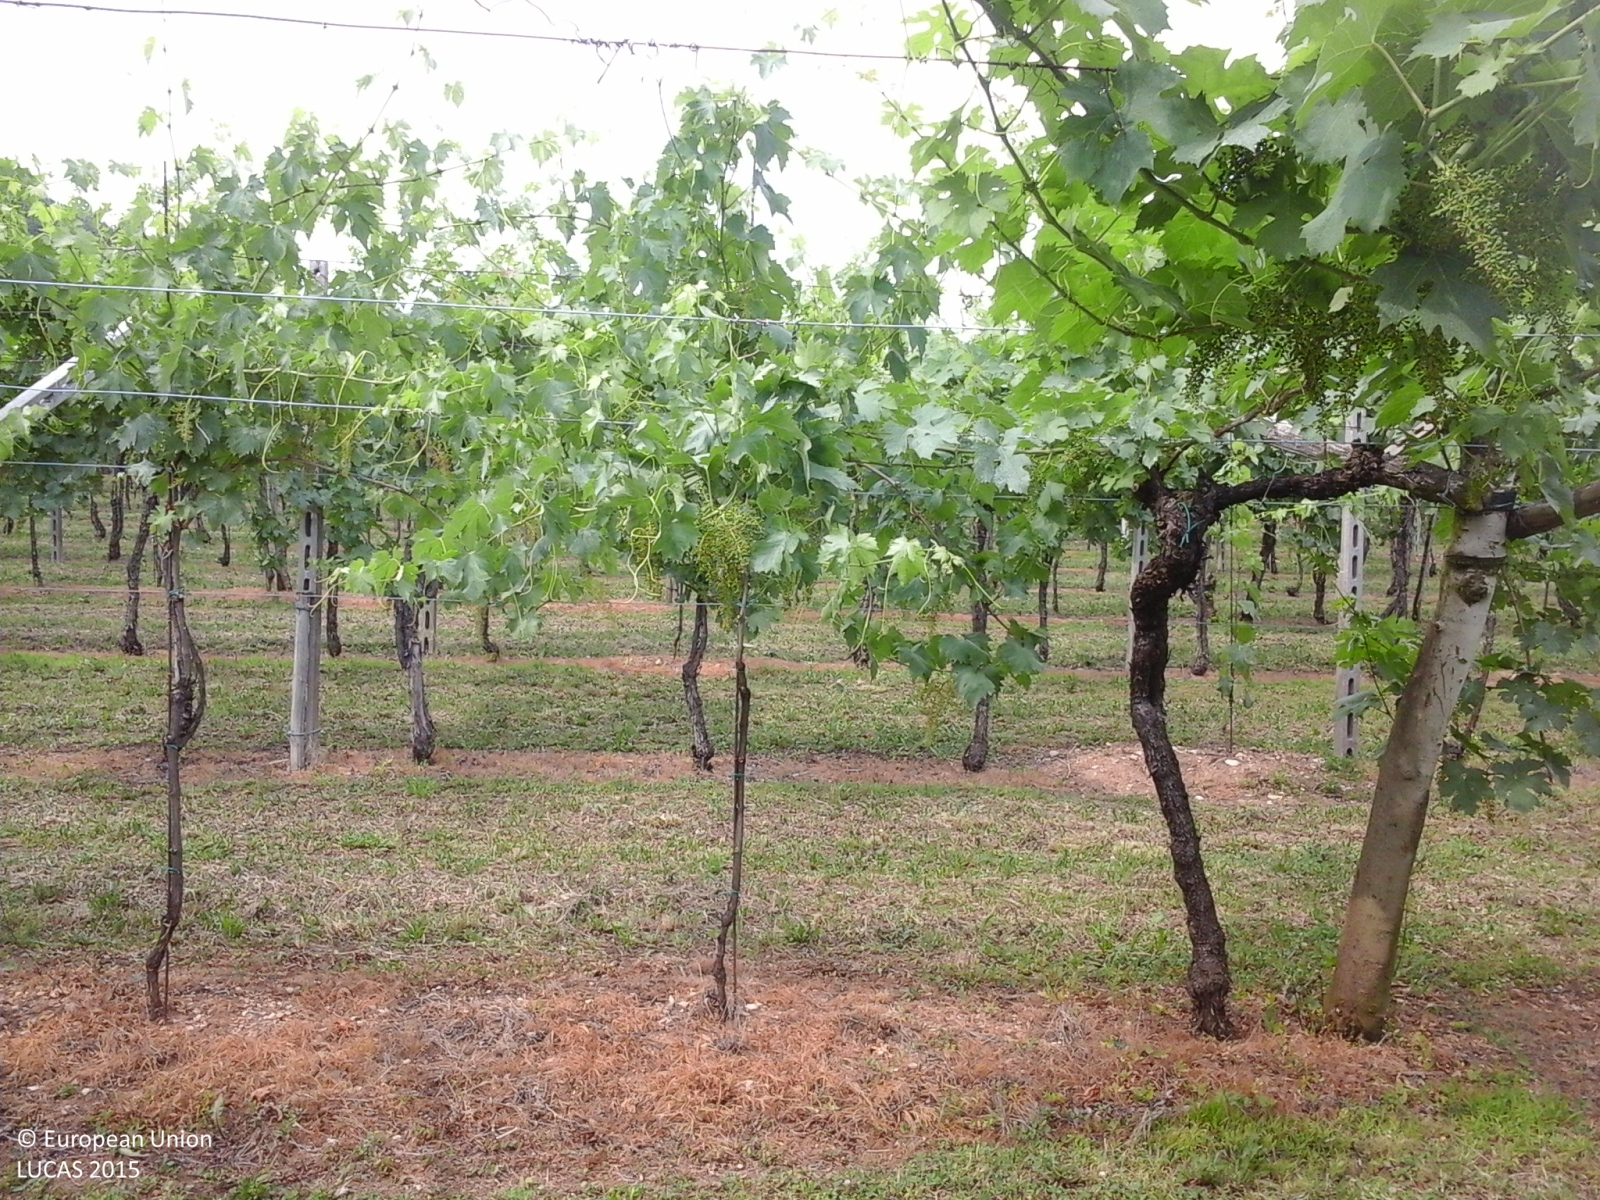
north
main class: Cropland
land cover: Vineyards
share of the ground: > 75 %
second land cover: Grassland without tree/shrub cover
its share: > 75 %
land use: Agriculture (excluding fallow land and kitchen gardens)
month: June
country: IT
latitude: 45.5363
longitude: 10.9333
